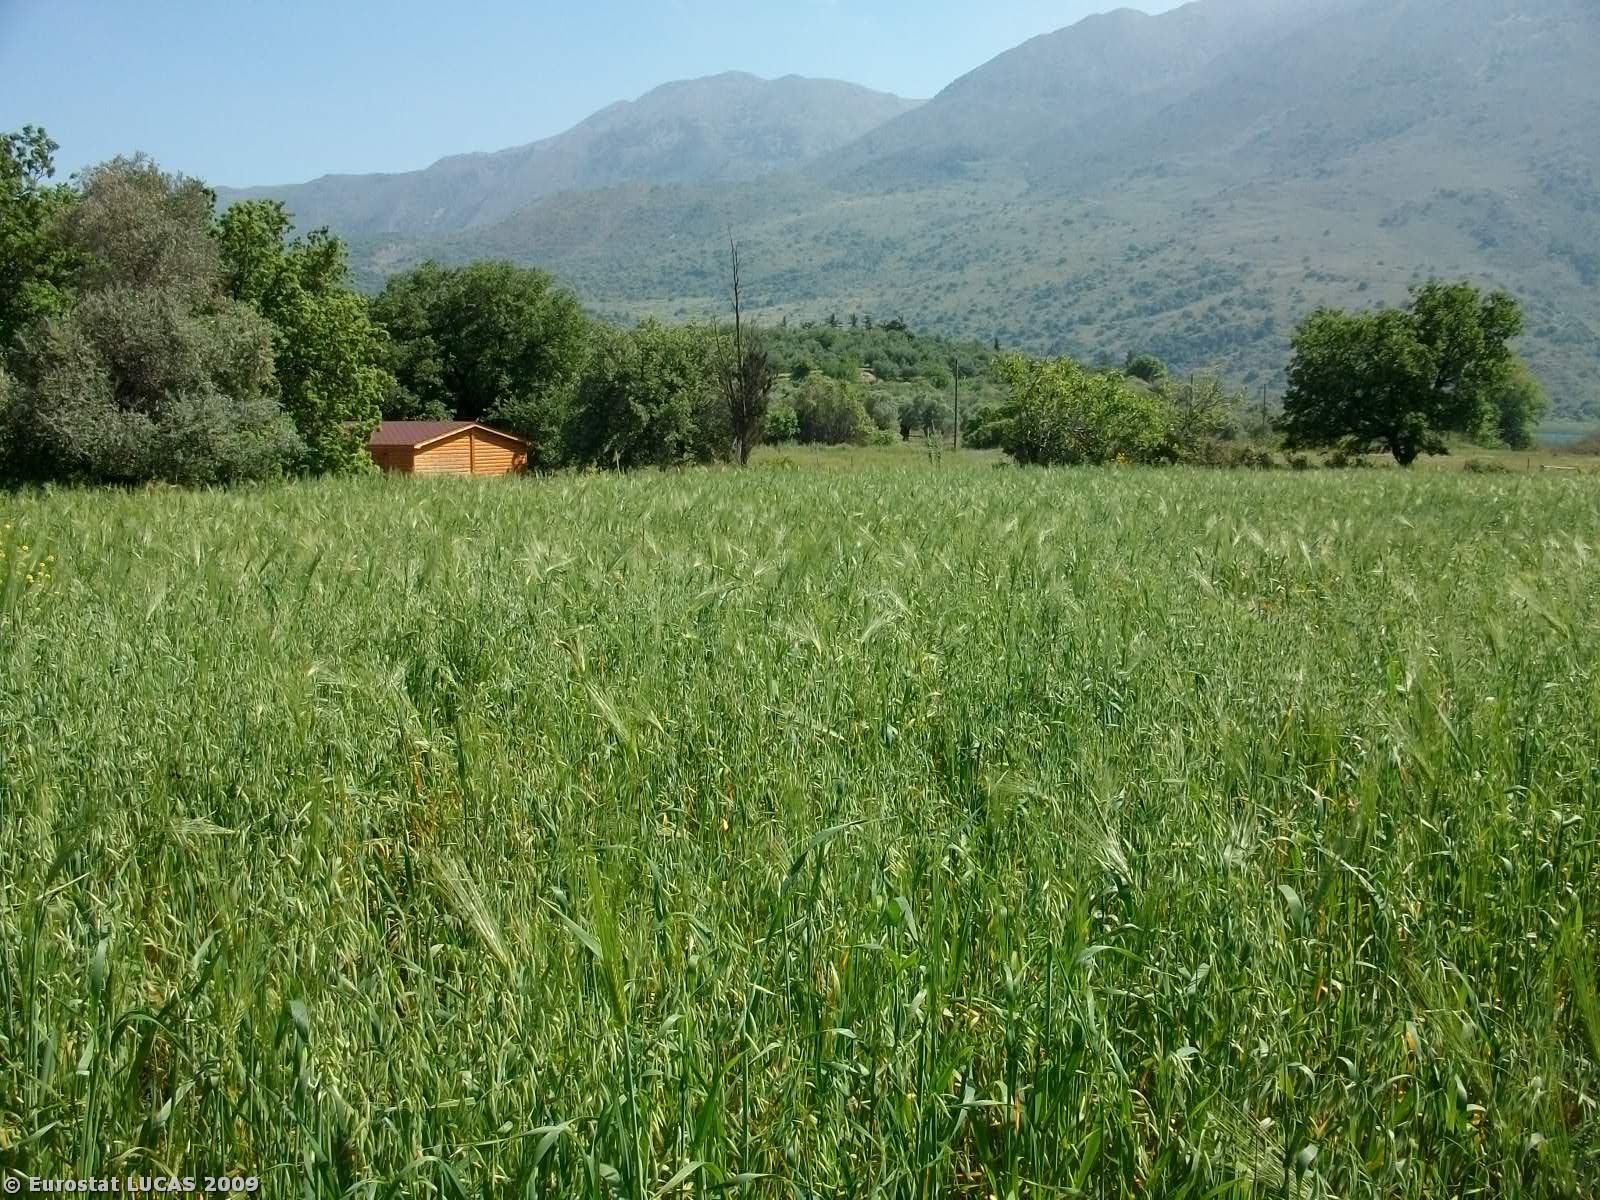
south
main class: Grassland
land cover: Spontaneously vegetated surfaces
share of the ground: > 75 %
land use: Fallow land
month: May
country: GR
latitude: 35.3394
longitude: 24.2770
